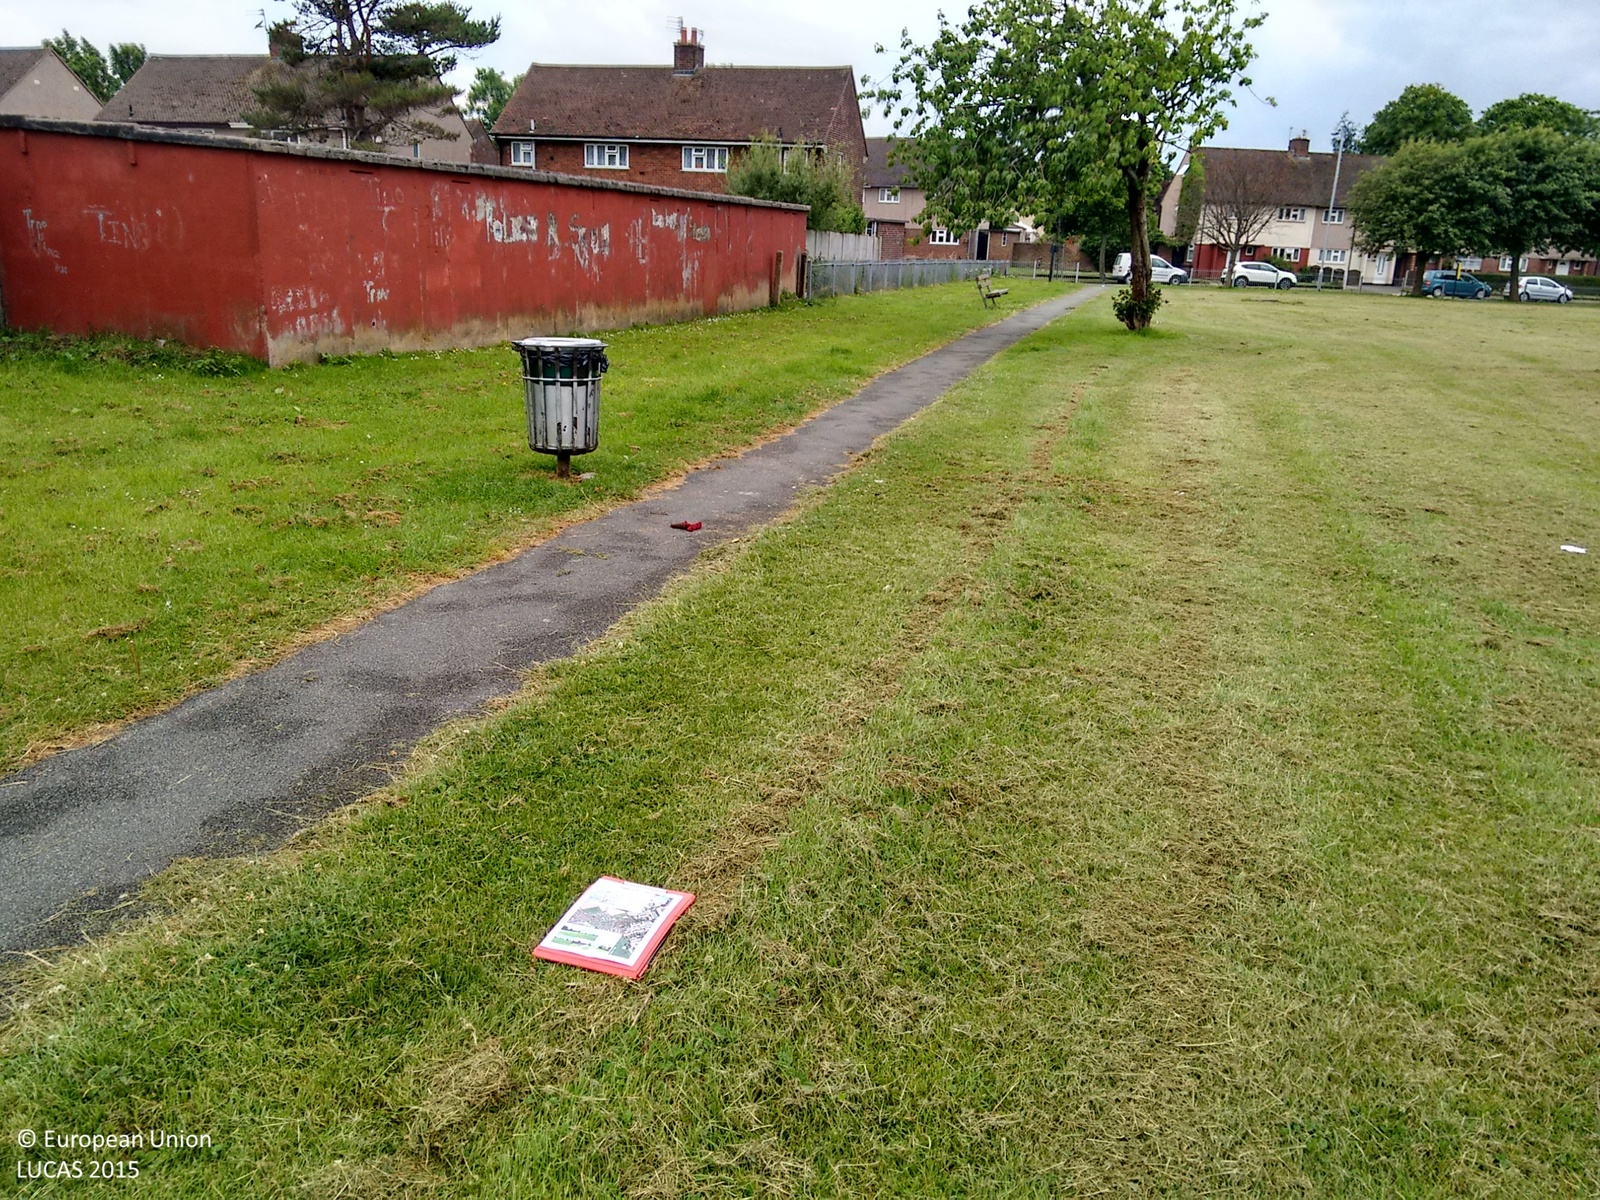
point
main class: Grassland
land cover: Grassland without tree/shrub cover
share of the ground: > 75 %
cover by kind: herbaceous plants 100 %
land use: Amenities, museums, leisure
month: June
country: GB
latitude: 53.4966
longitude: -3.0234
